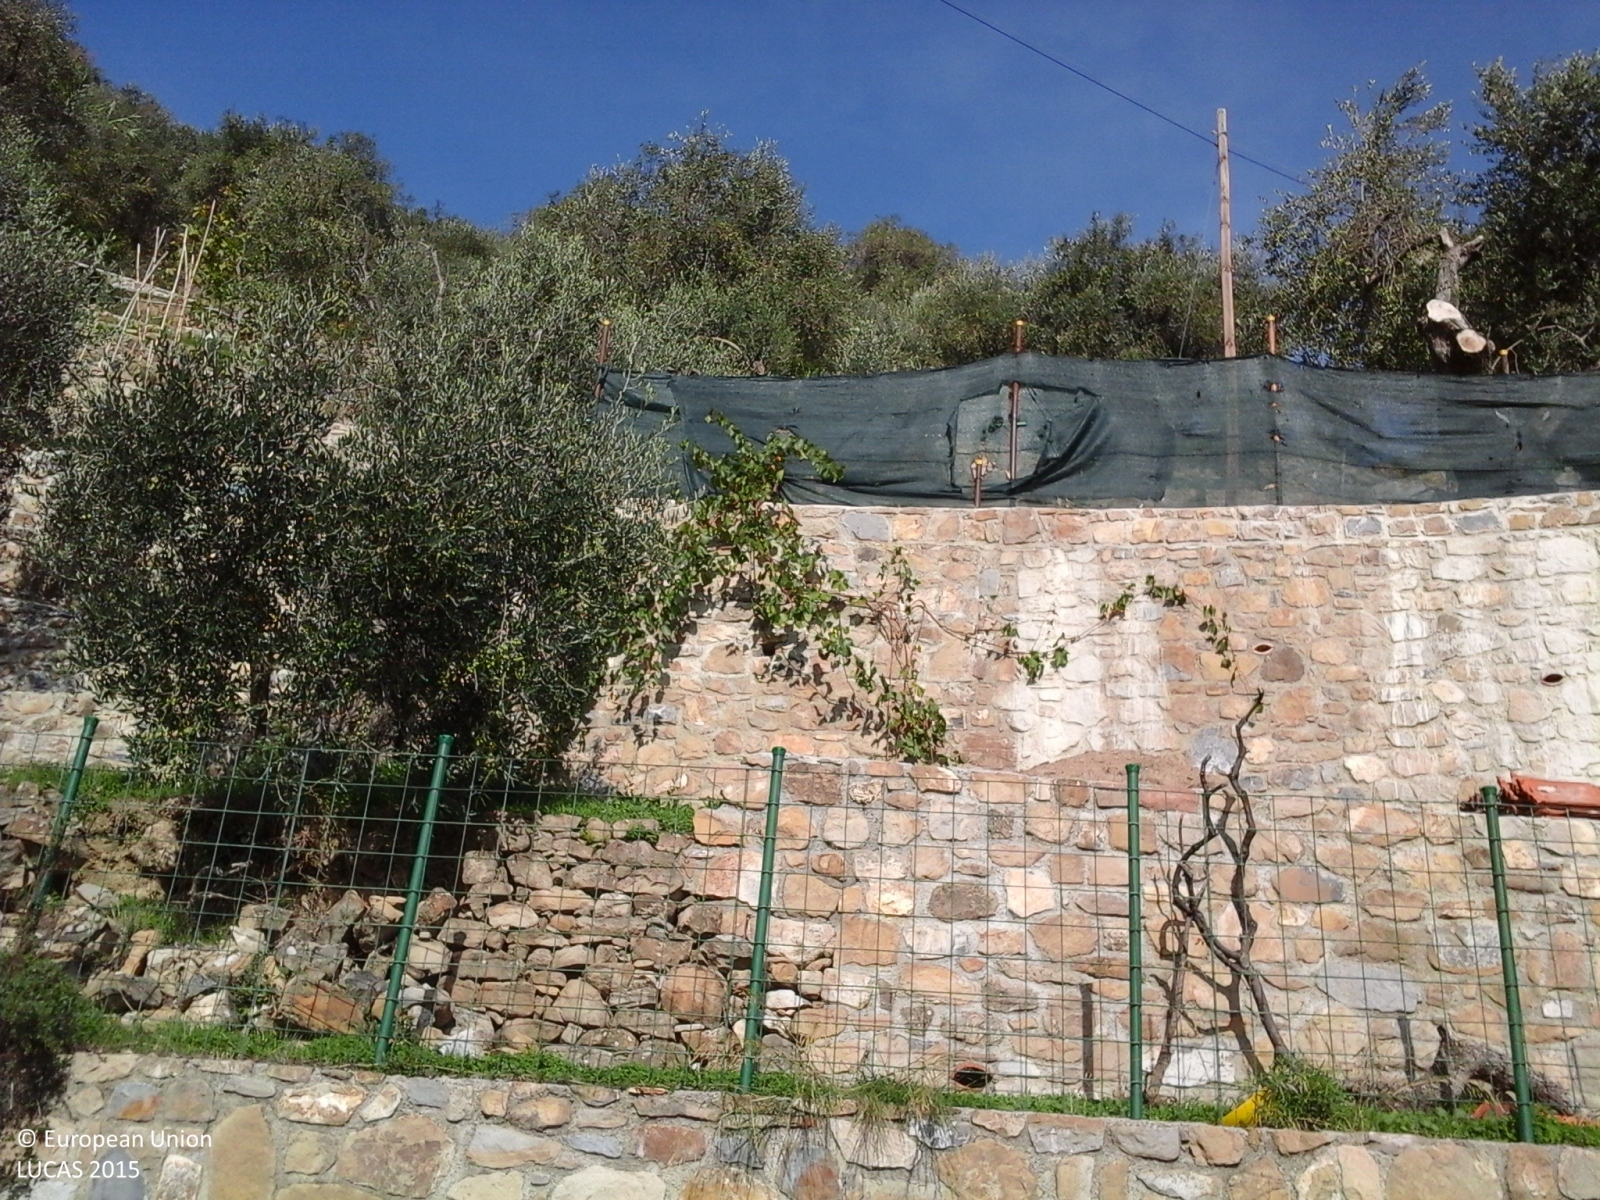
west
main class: Woodland
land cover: Broadleaved woodland
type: thermophilous deciduous forest
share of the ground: > 75 %
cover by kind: broadleaved forest trees 80 %, shrubs 10 %, herbaceous plants 10 %
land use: Semi-natural and natural areas not in use
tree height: > 5 m
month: October
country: IT
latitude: 43.8581
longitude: 7.8033
